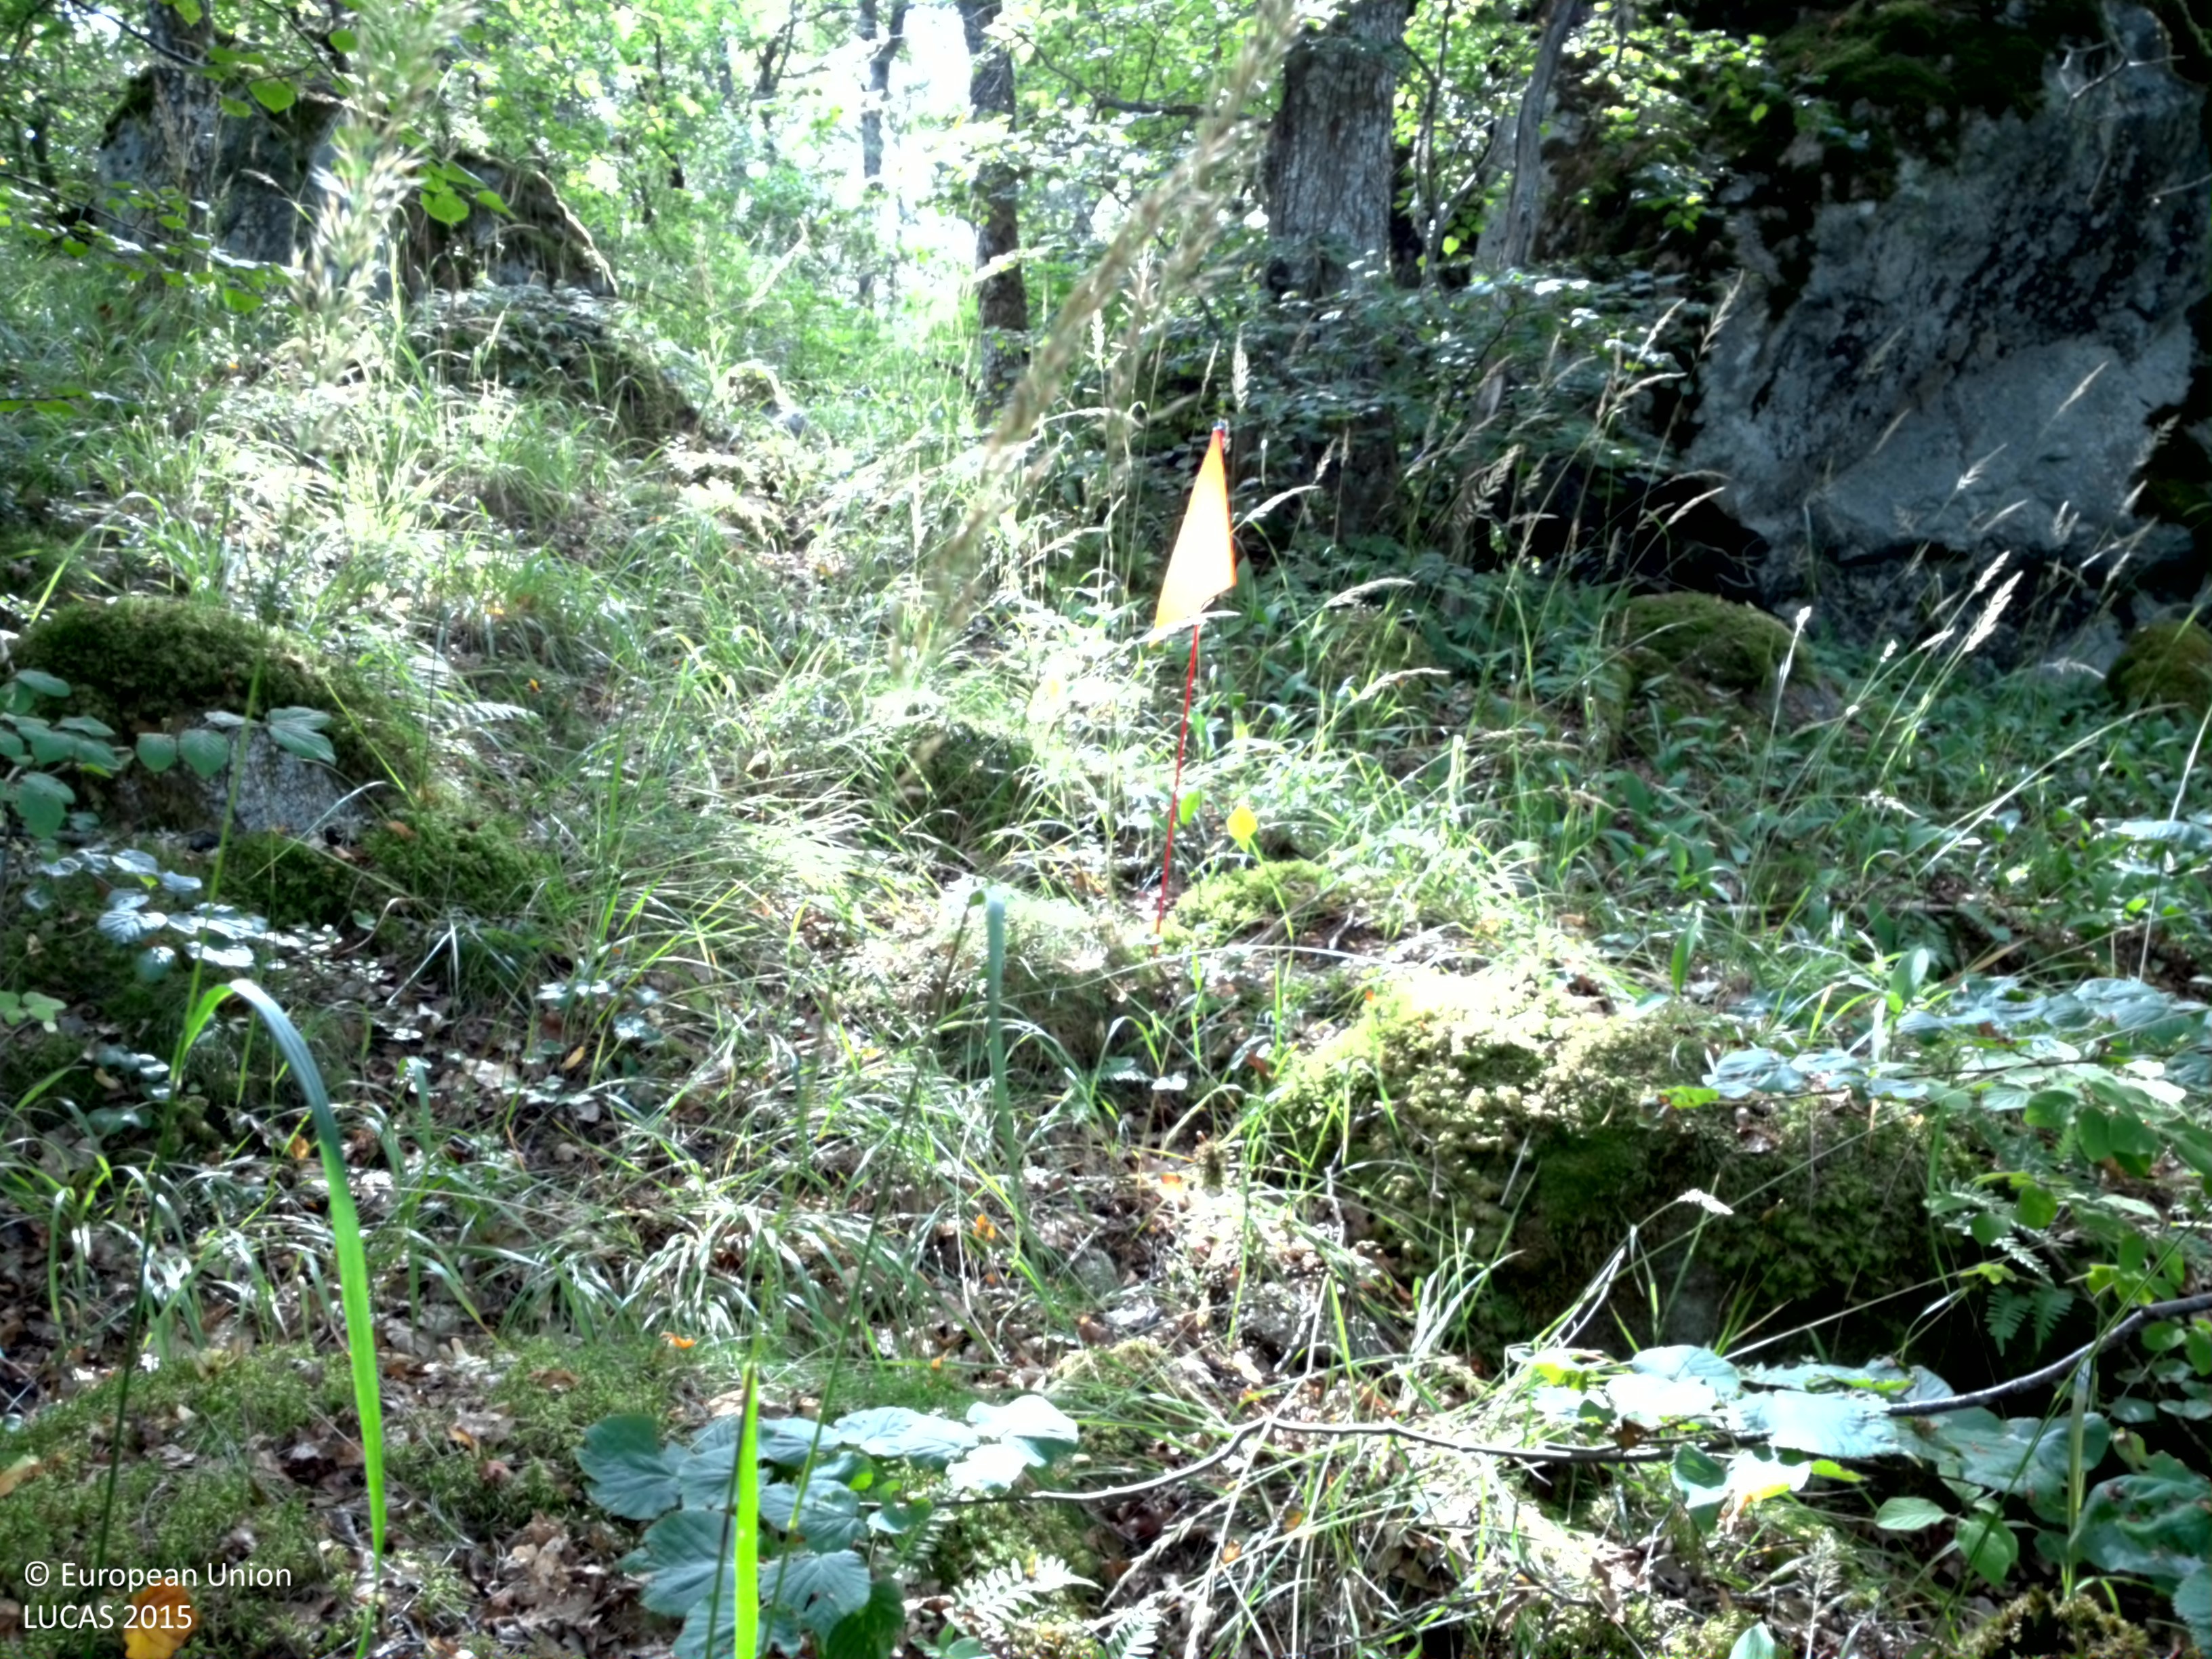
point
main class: Woodland
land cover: Broadleaved woodland
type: hemiboreal forest and nemoral coniferous forest and mixed broadleaved-coniferous forest
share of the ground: > 75 %
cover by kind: broadleaved forest trees 80 %, herbaceous plants 15 %, shrubs 5 %
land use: Forestry
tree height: > 5 m
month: August
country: SE
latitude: 59.8820
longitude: 17.9820
